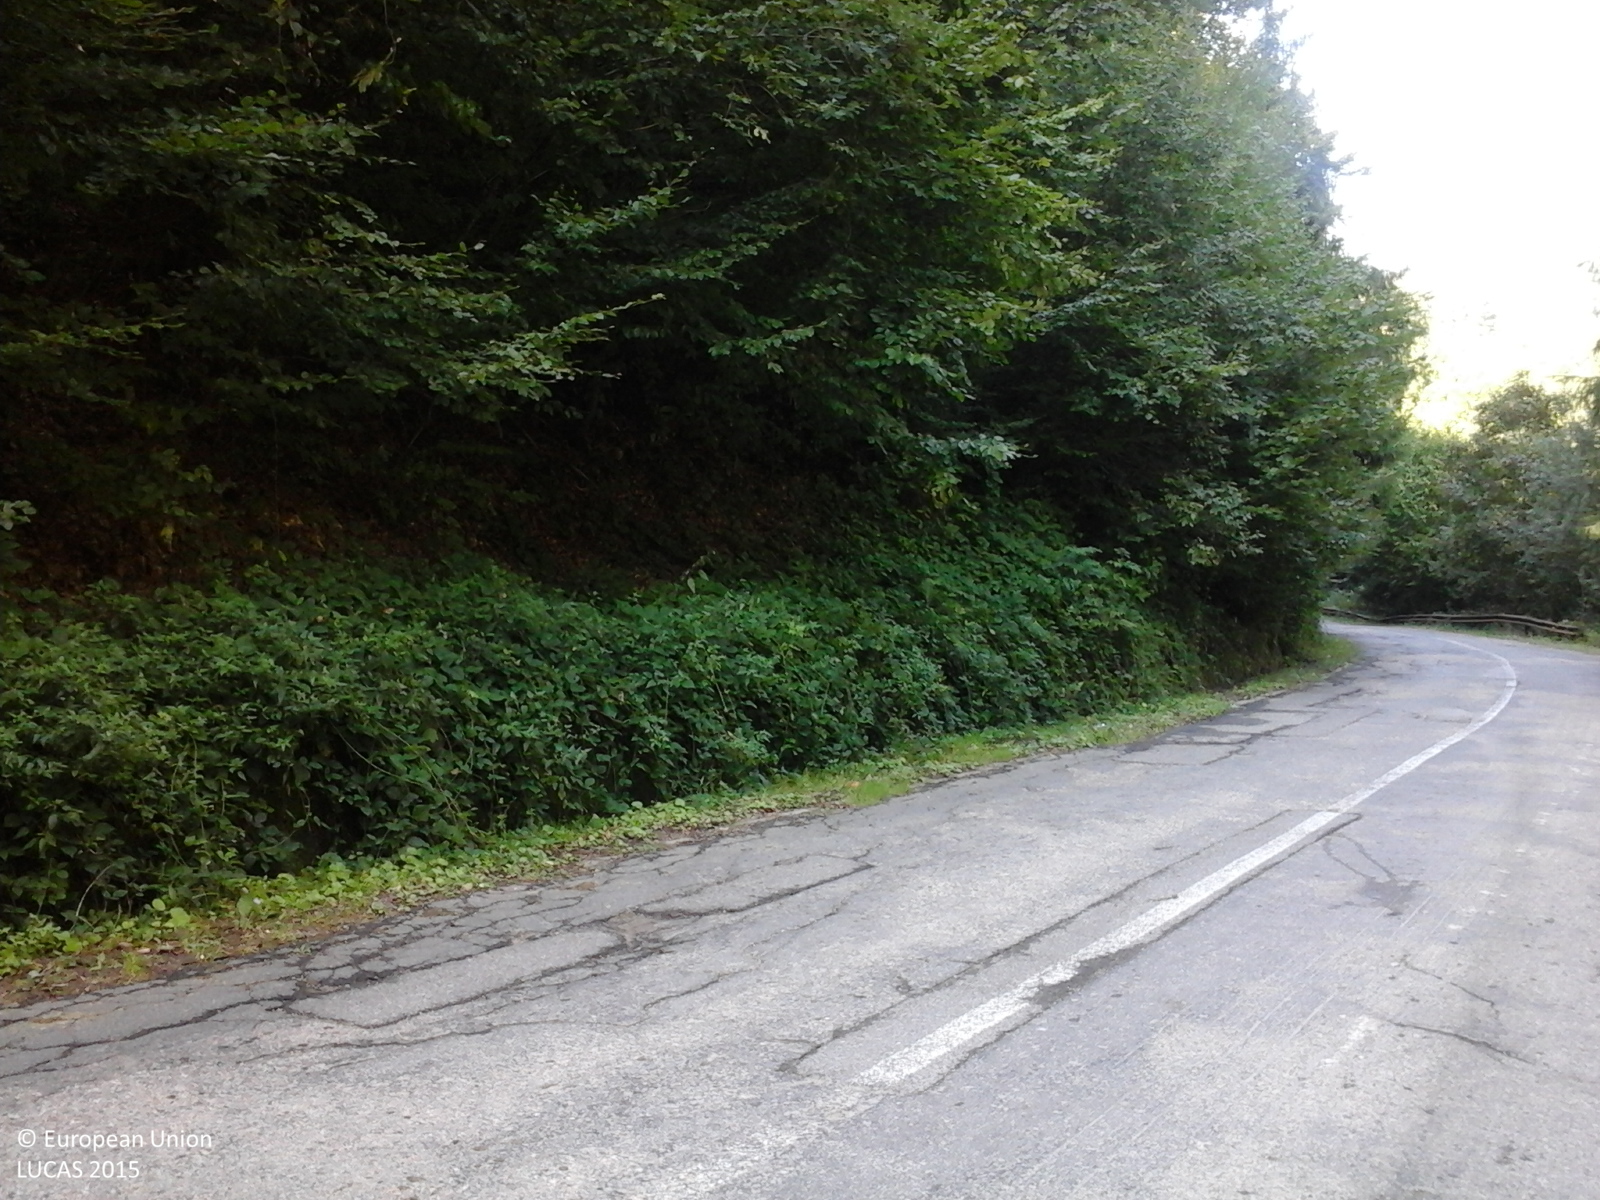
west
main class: Woodland
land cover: Spruce dominated mixed woodland
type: hemiboreal forest and nemoral coniferous forest and mixed broadleaved-coniferous forest
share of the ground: > 75 %
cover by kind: coniferous forest trees 60 %, broadleaved forest trees 40 %
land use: Forestry
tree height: > 5 m
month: September
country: RO
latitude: 46.6847
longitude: 22.5393
